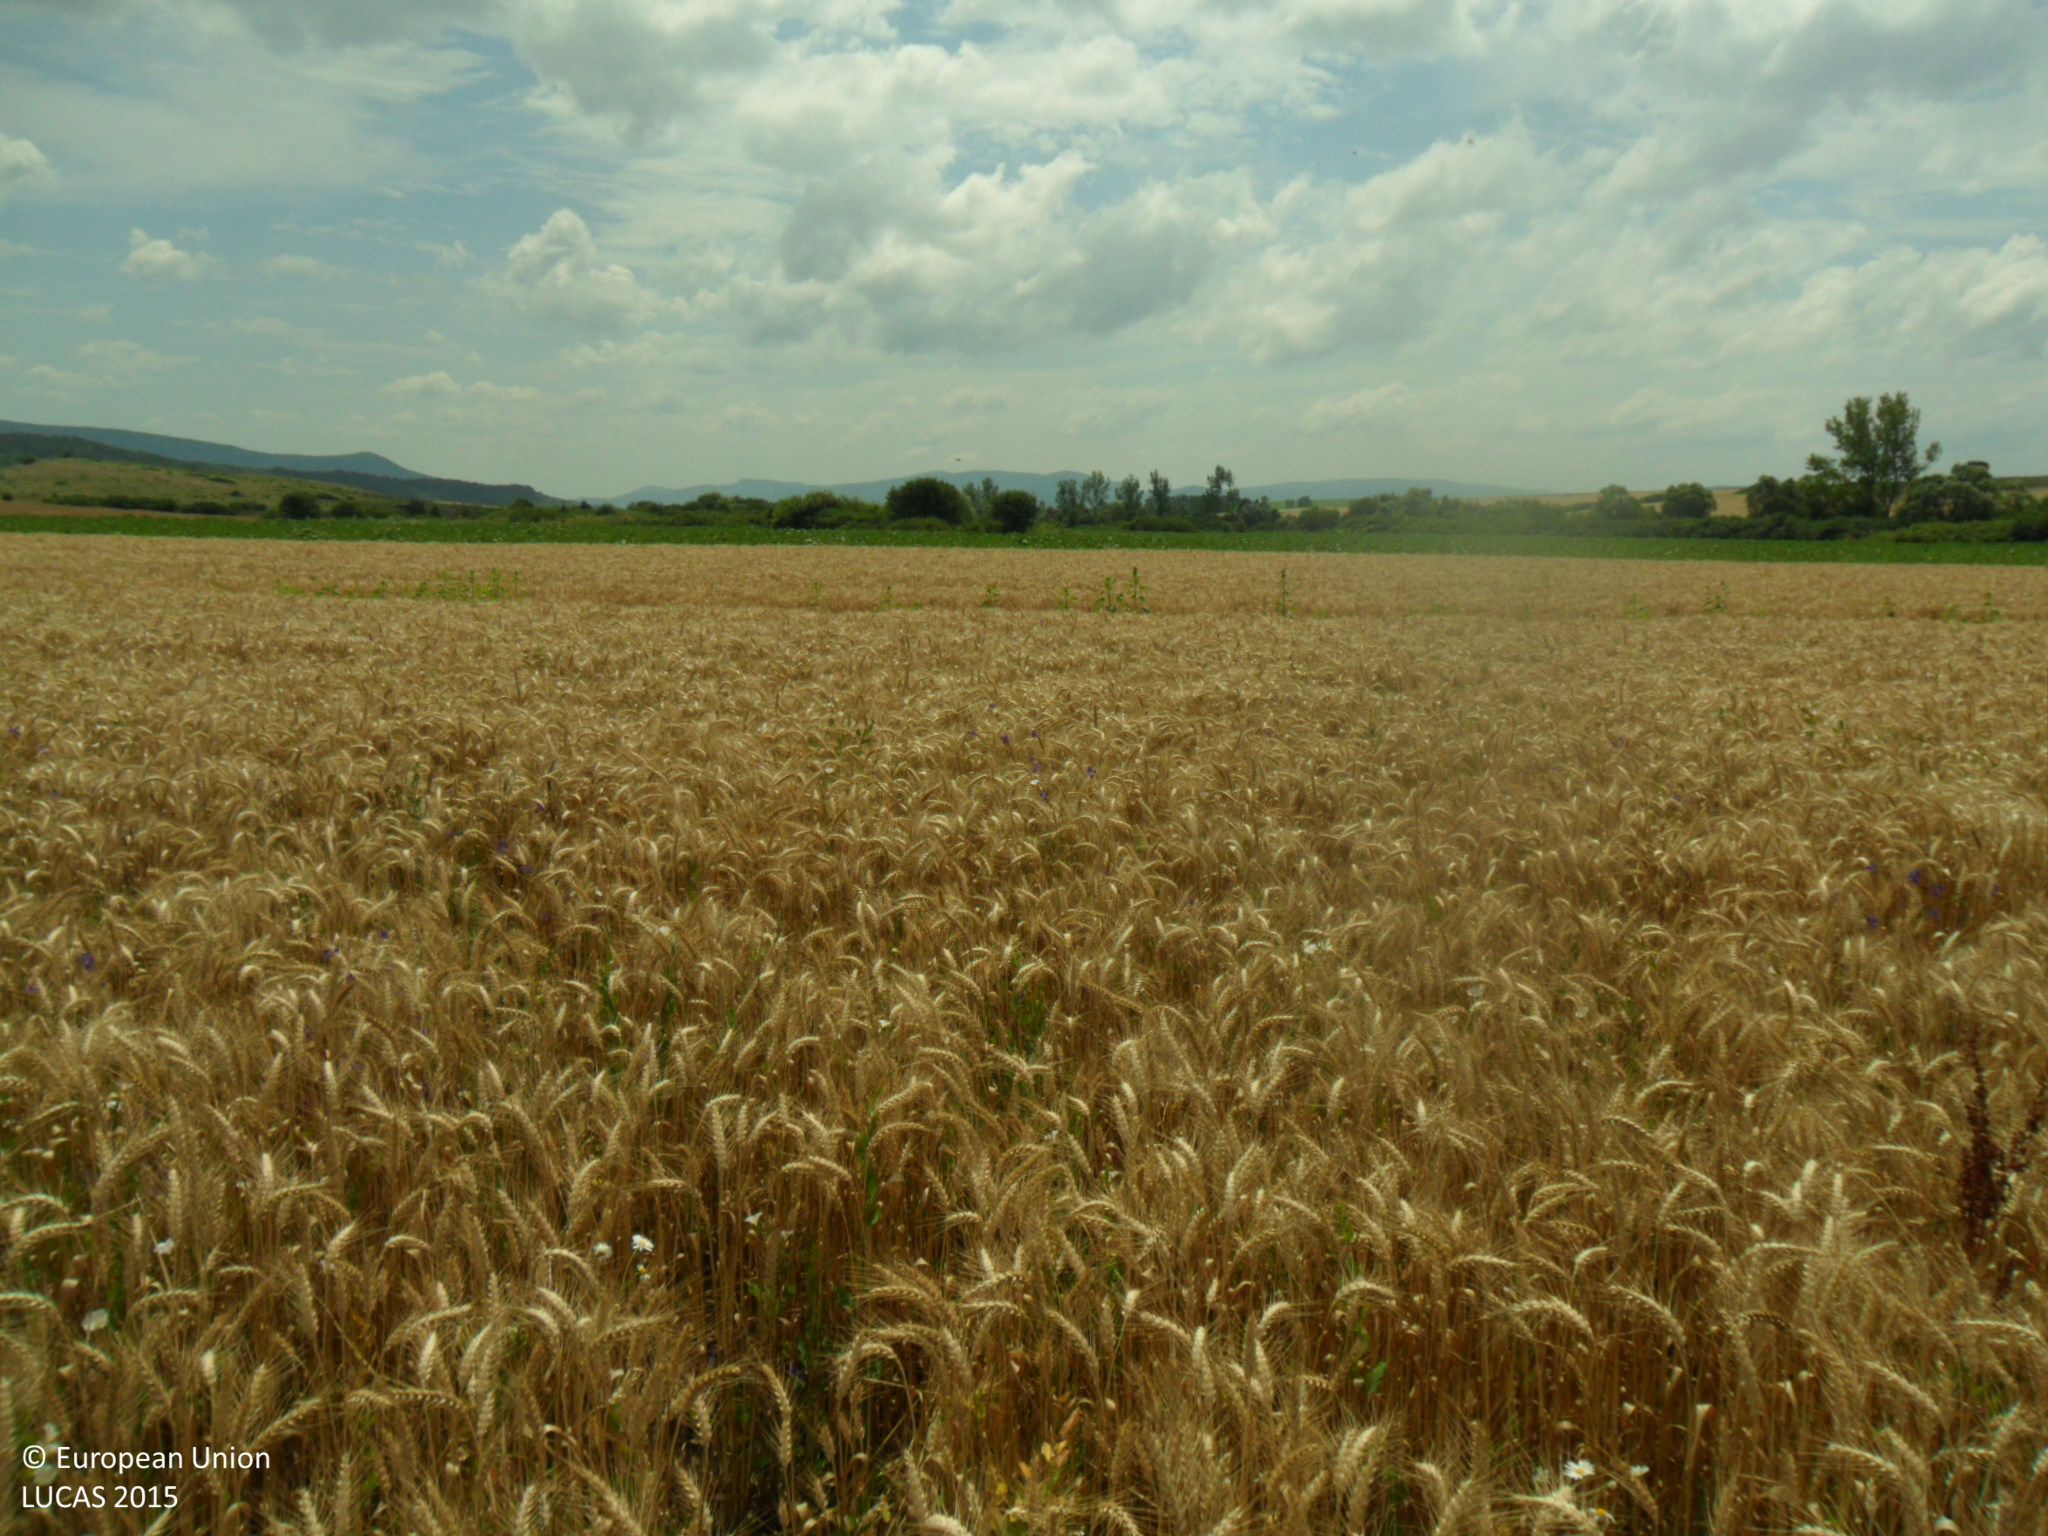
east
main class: Cropland
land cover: Common wheat
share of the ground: > 75 %
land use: Agriculture (excluding fallow land and kitchen gardens)
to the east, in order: Common wheat; Sunflower; Grass margins; Rivers and streams; Grass margins; Common wheat
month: June
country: BG
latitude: 43.1254
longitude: 26.9638
